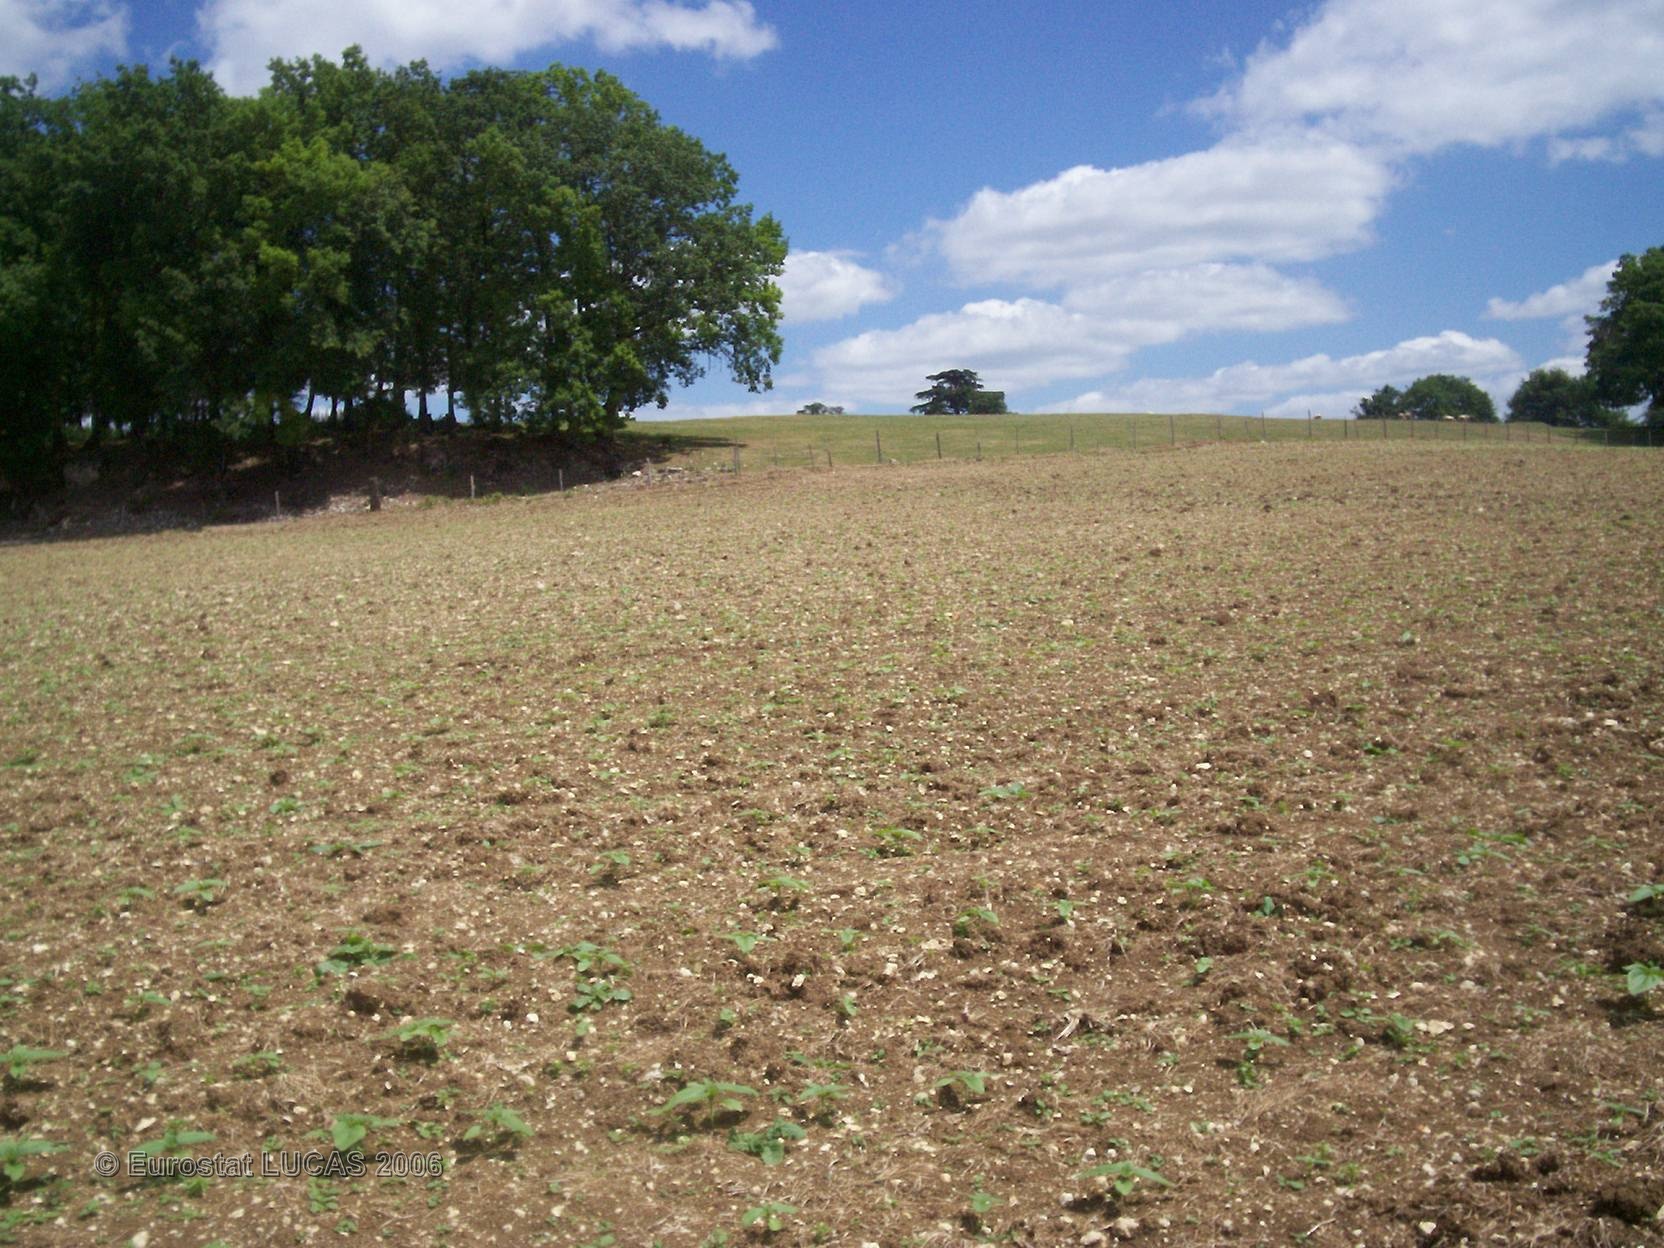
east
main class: Cropland
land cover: Sunflower
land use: Agriculture (excluding fallow land and kitchen gardens)
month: May
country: FR
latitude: 44.2732
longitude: 0.8625
